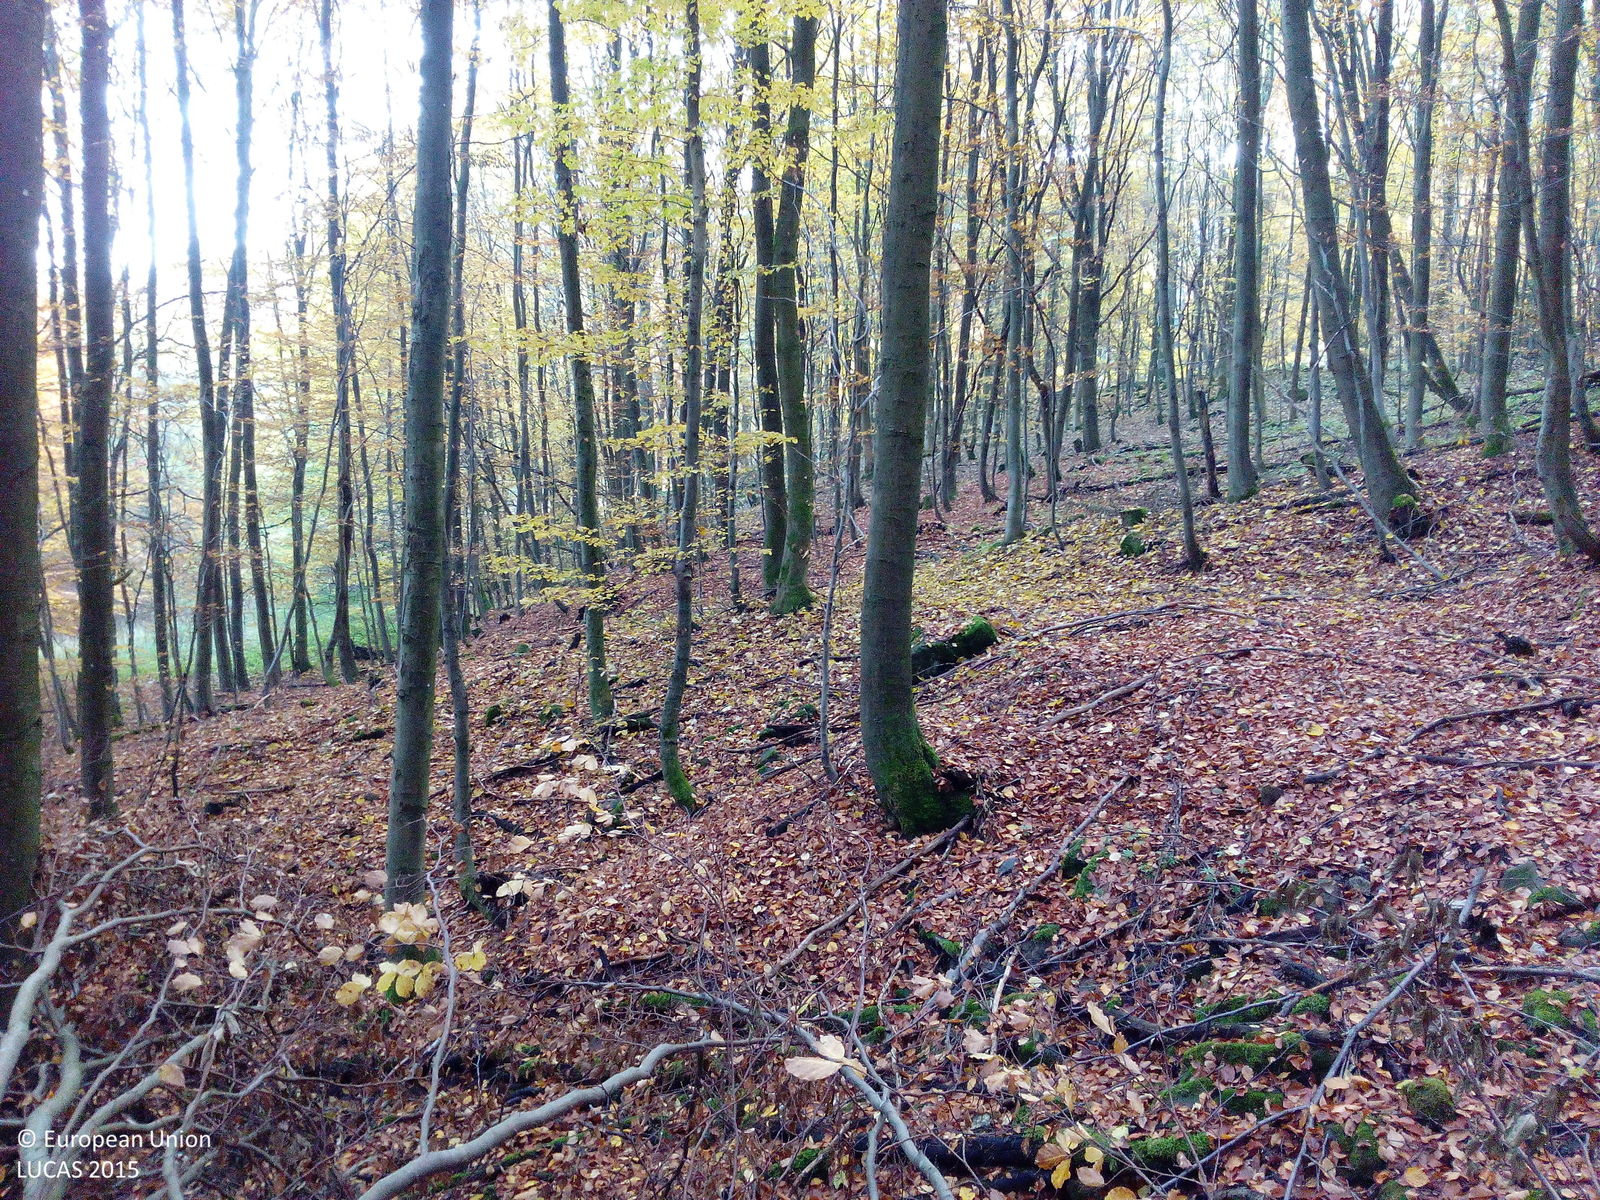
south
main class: Woodland
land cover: Broadleaved woodland
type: mesophytic deciduous forest
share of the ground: > 75 %
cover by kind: broadleaved forest trees 75 %, unconsolidated bare surface 20 %, herbaceous plants 5 %
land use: Forestry
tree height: > 5 m
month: October
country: DE
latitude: 50.3101
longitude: 9.9298
